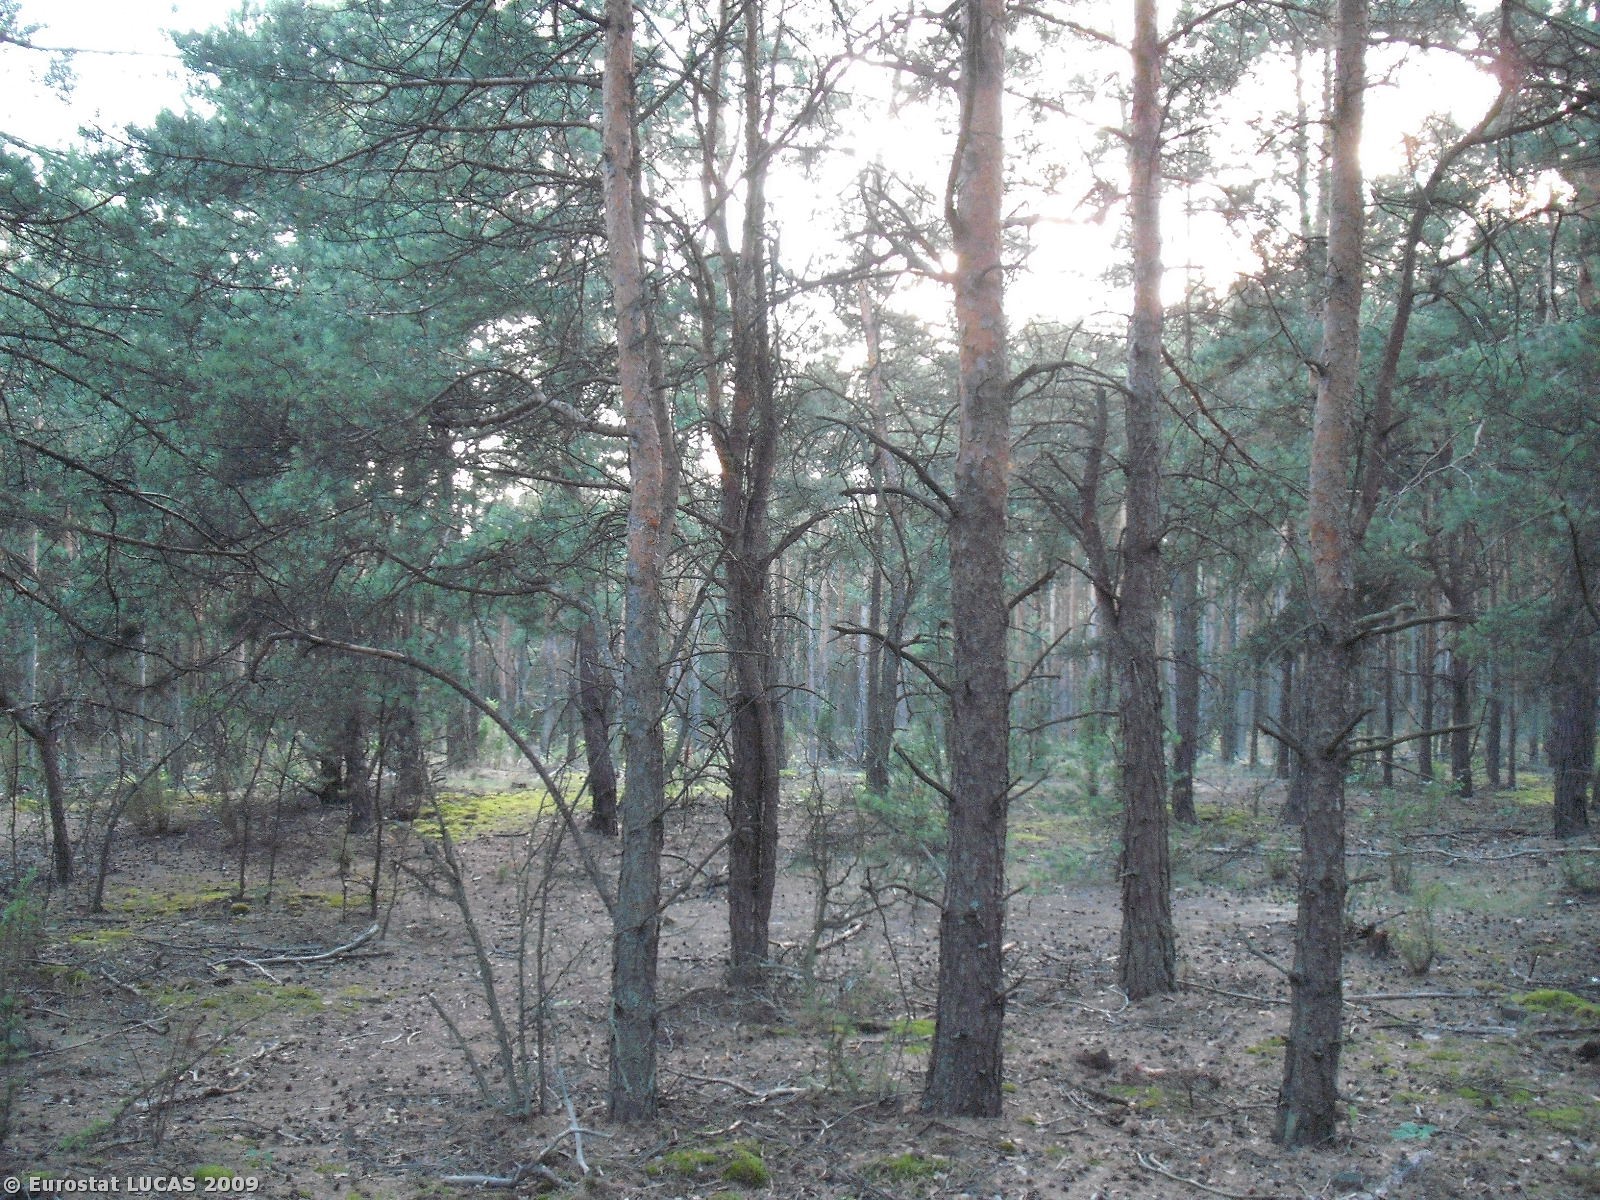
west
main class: Woodland
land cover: Coniferous woodland
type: hemiboreal forest and nemoral coniferous forest and mixed broadleaved-coniferous forest
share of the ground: > 75 %
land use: Forestry
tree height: > 5 m
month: July
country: PL
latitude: 52.2836
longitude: 20.7865
